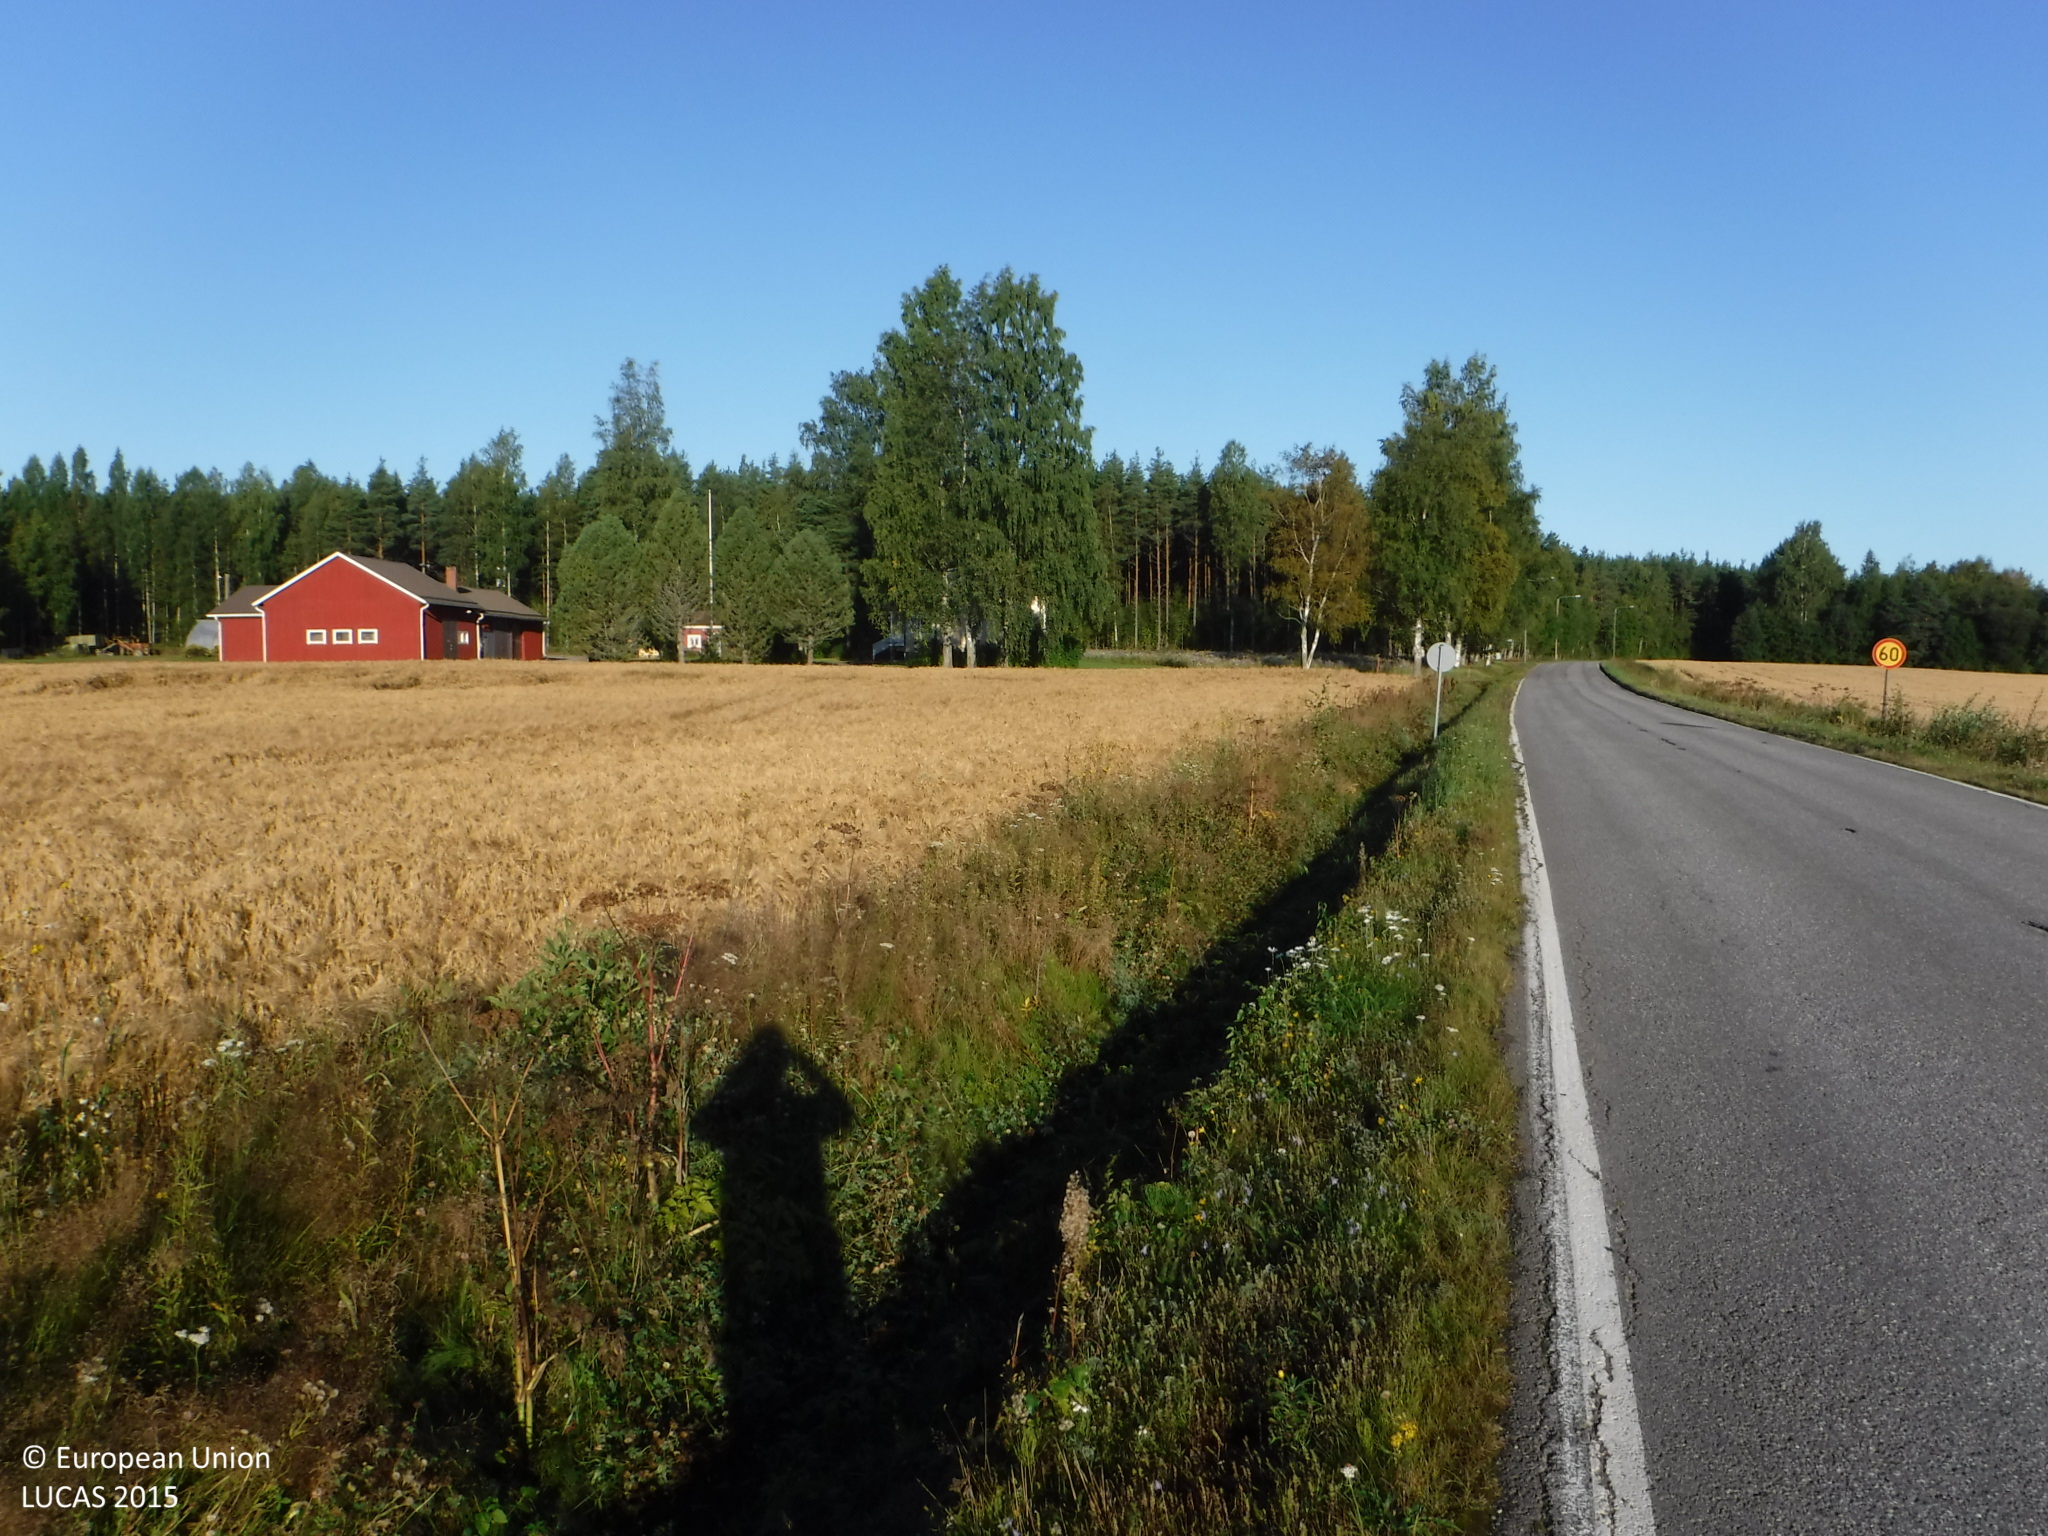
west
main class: Cropland
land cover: Barley
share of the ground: > 75 %
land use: Agriculture (excluding fallow land and kitchen gardens)
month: August
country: FI
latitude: 61.2910
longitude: 22.2096
